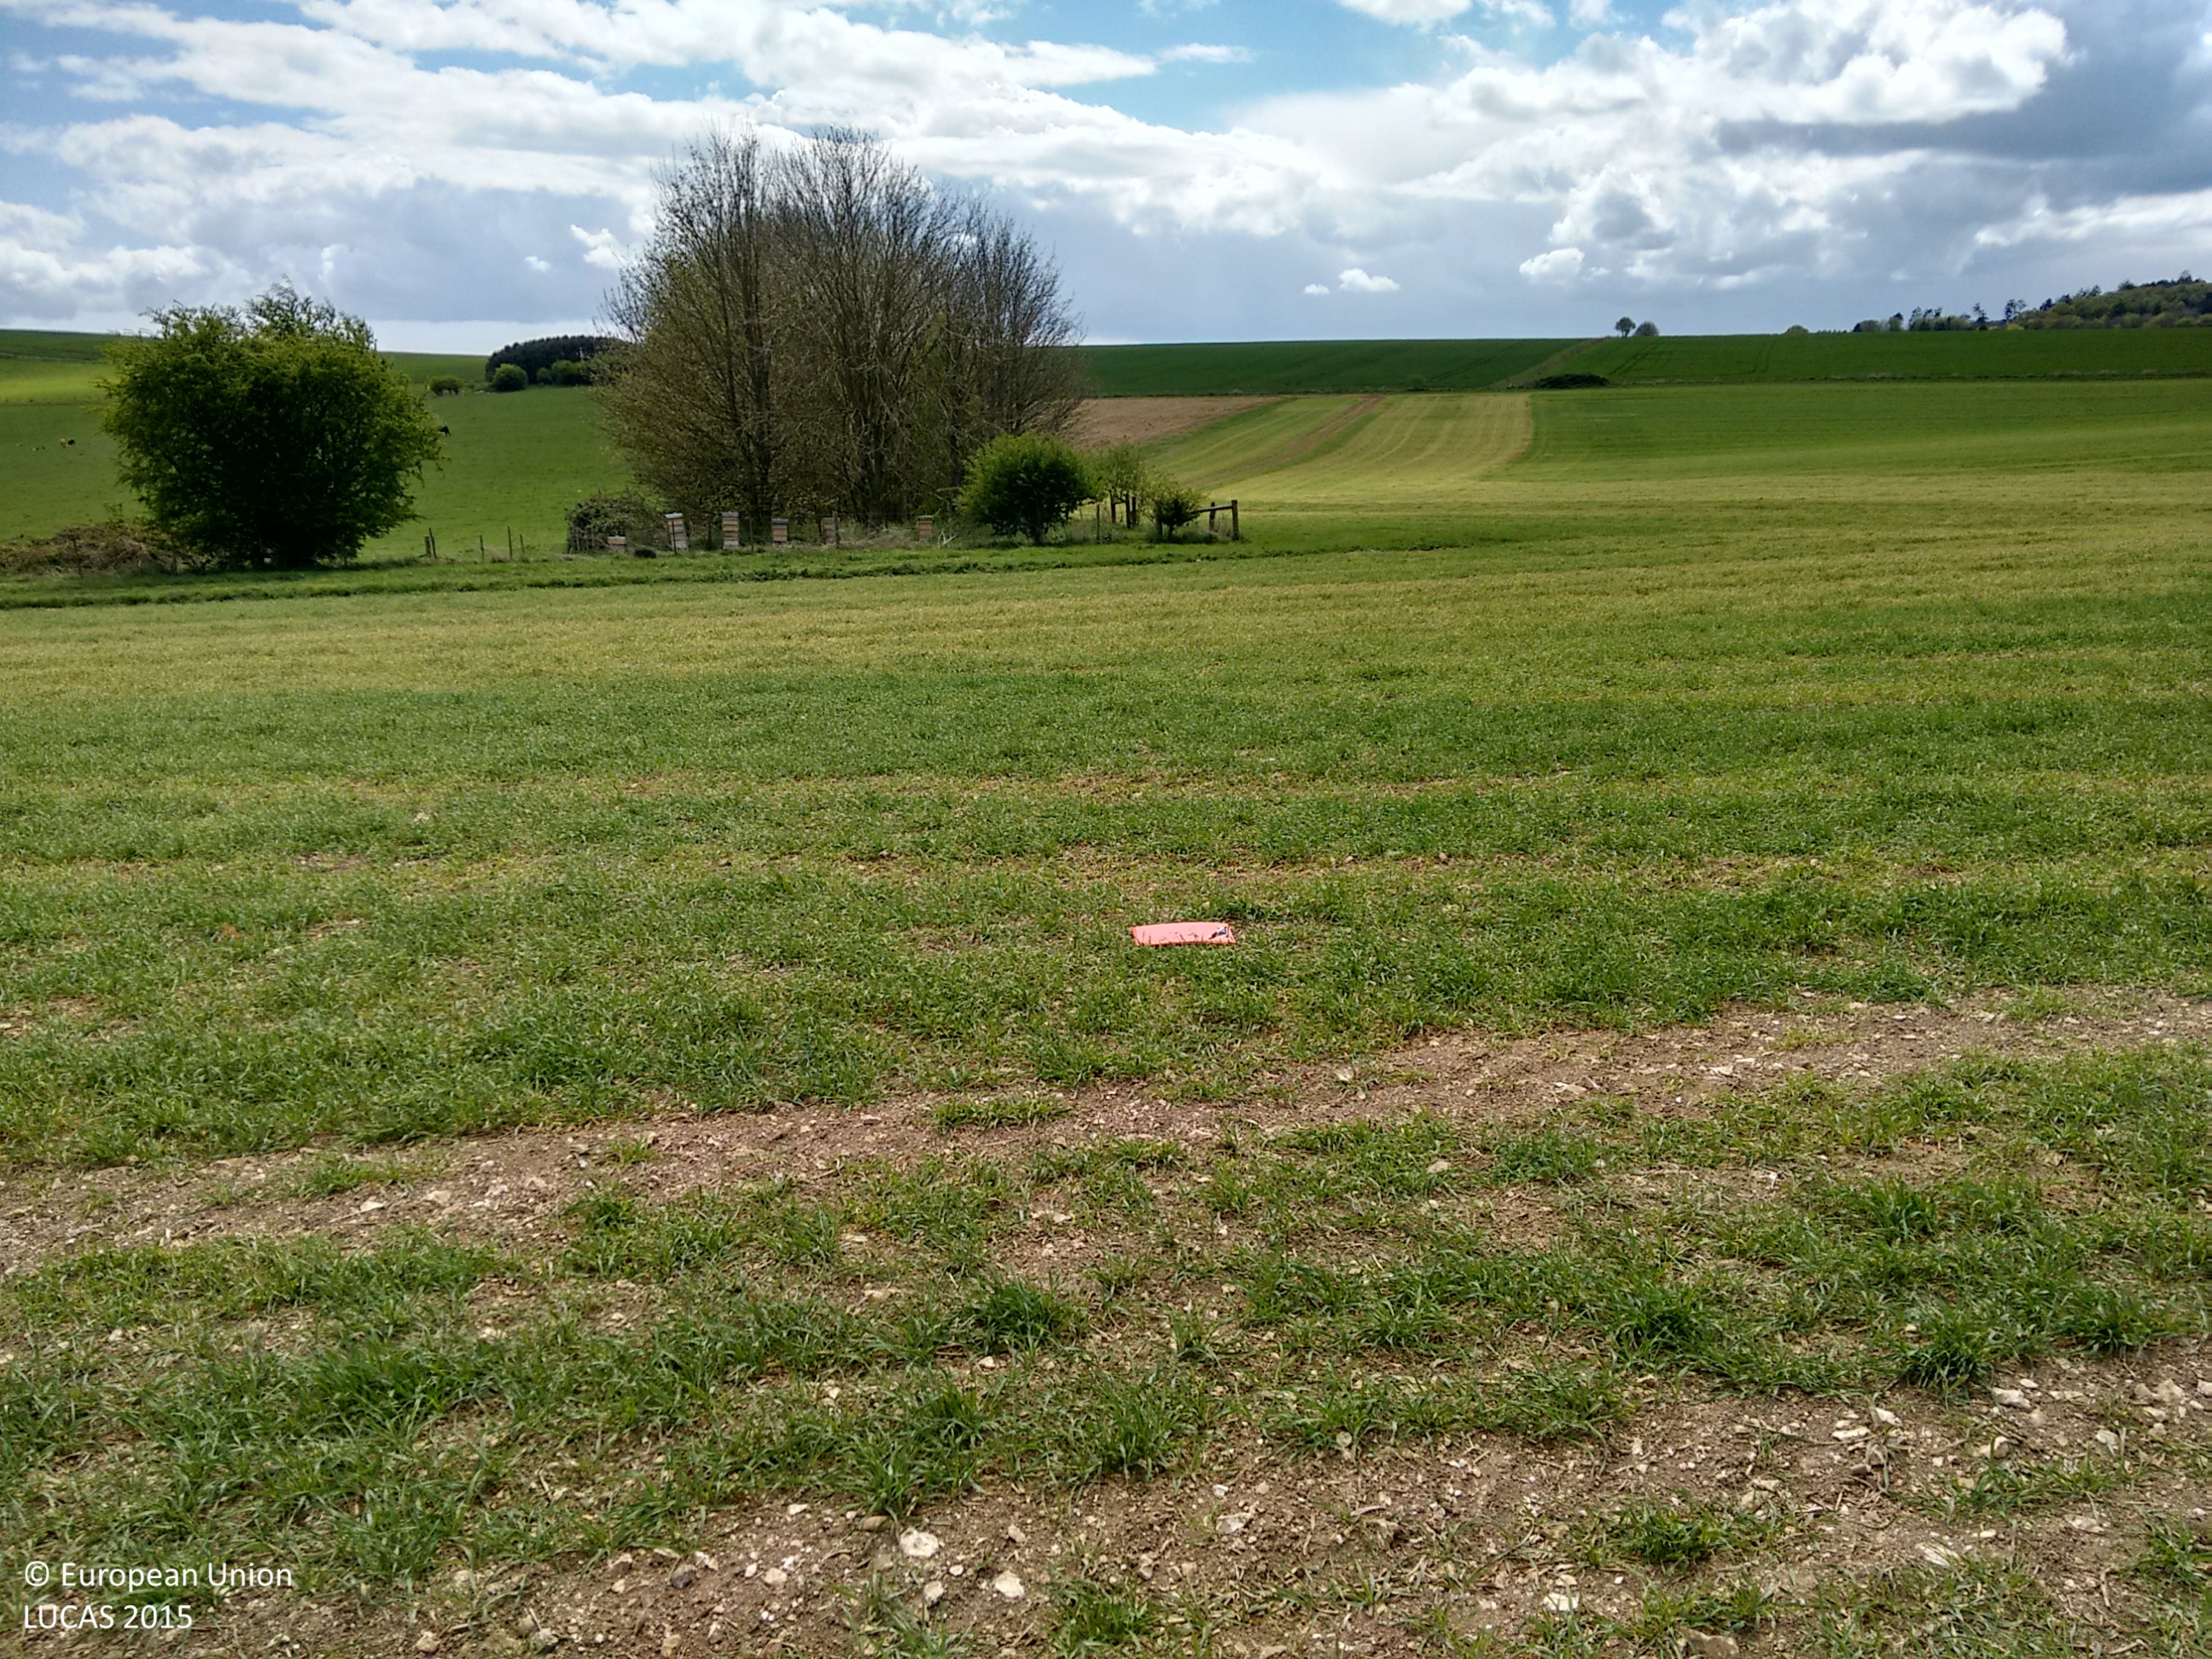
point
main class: Cropland
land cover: Barley
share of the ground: 50 - 75 %
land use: Agriculture (excluding fallow land and kitchen gardens)
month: April
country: GB
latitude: 50.9595
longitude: -1.8878
